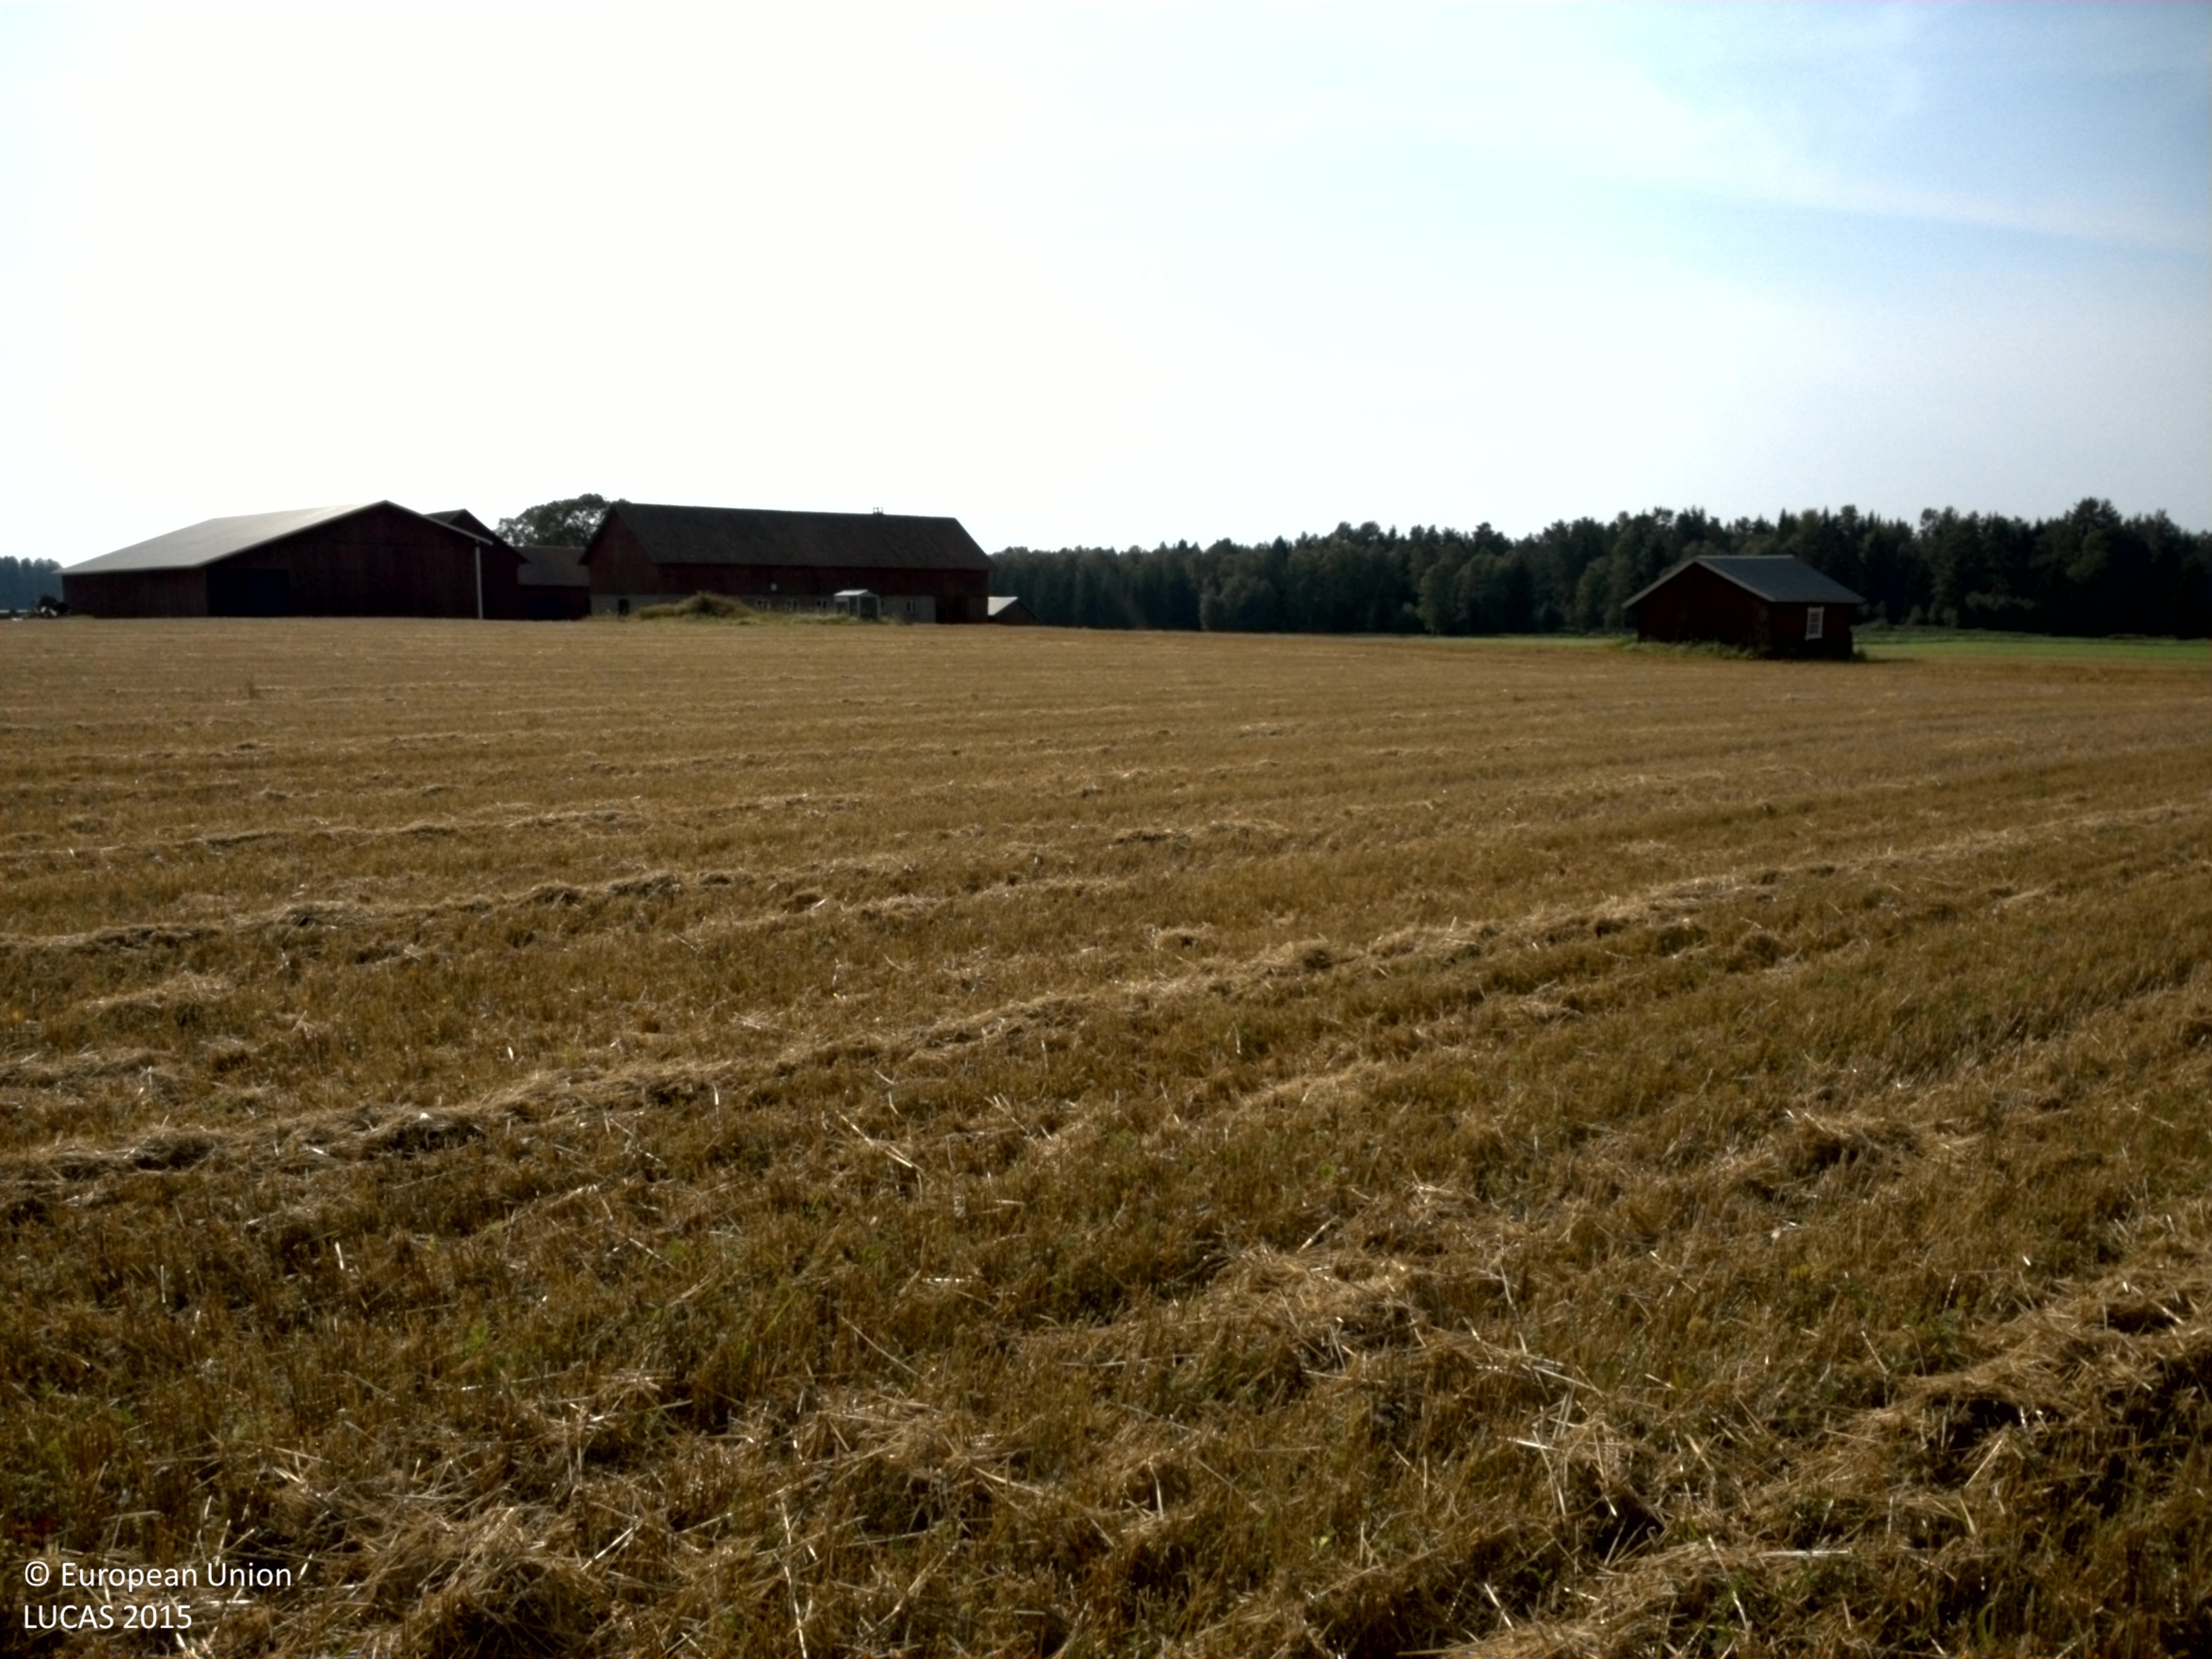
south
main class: Cropland
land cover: Barley
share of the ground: > 75 %
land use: Agriculture (excluding fallow land and kitchen gardens)
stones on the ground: < 10 %
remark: Harvested field
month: August
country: SE
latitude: 60.1061
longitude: 17.5297
